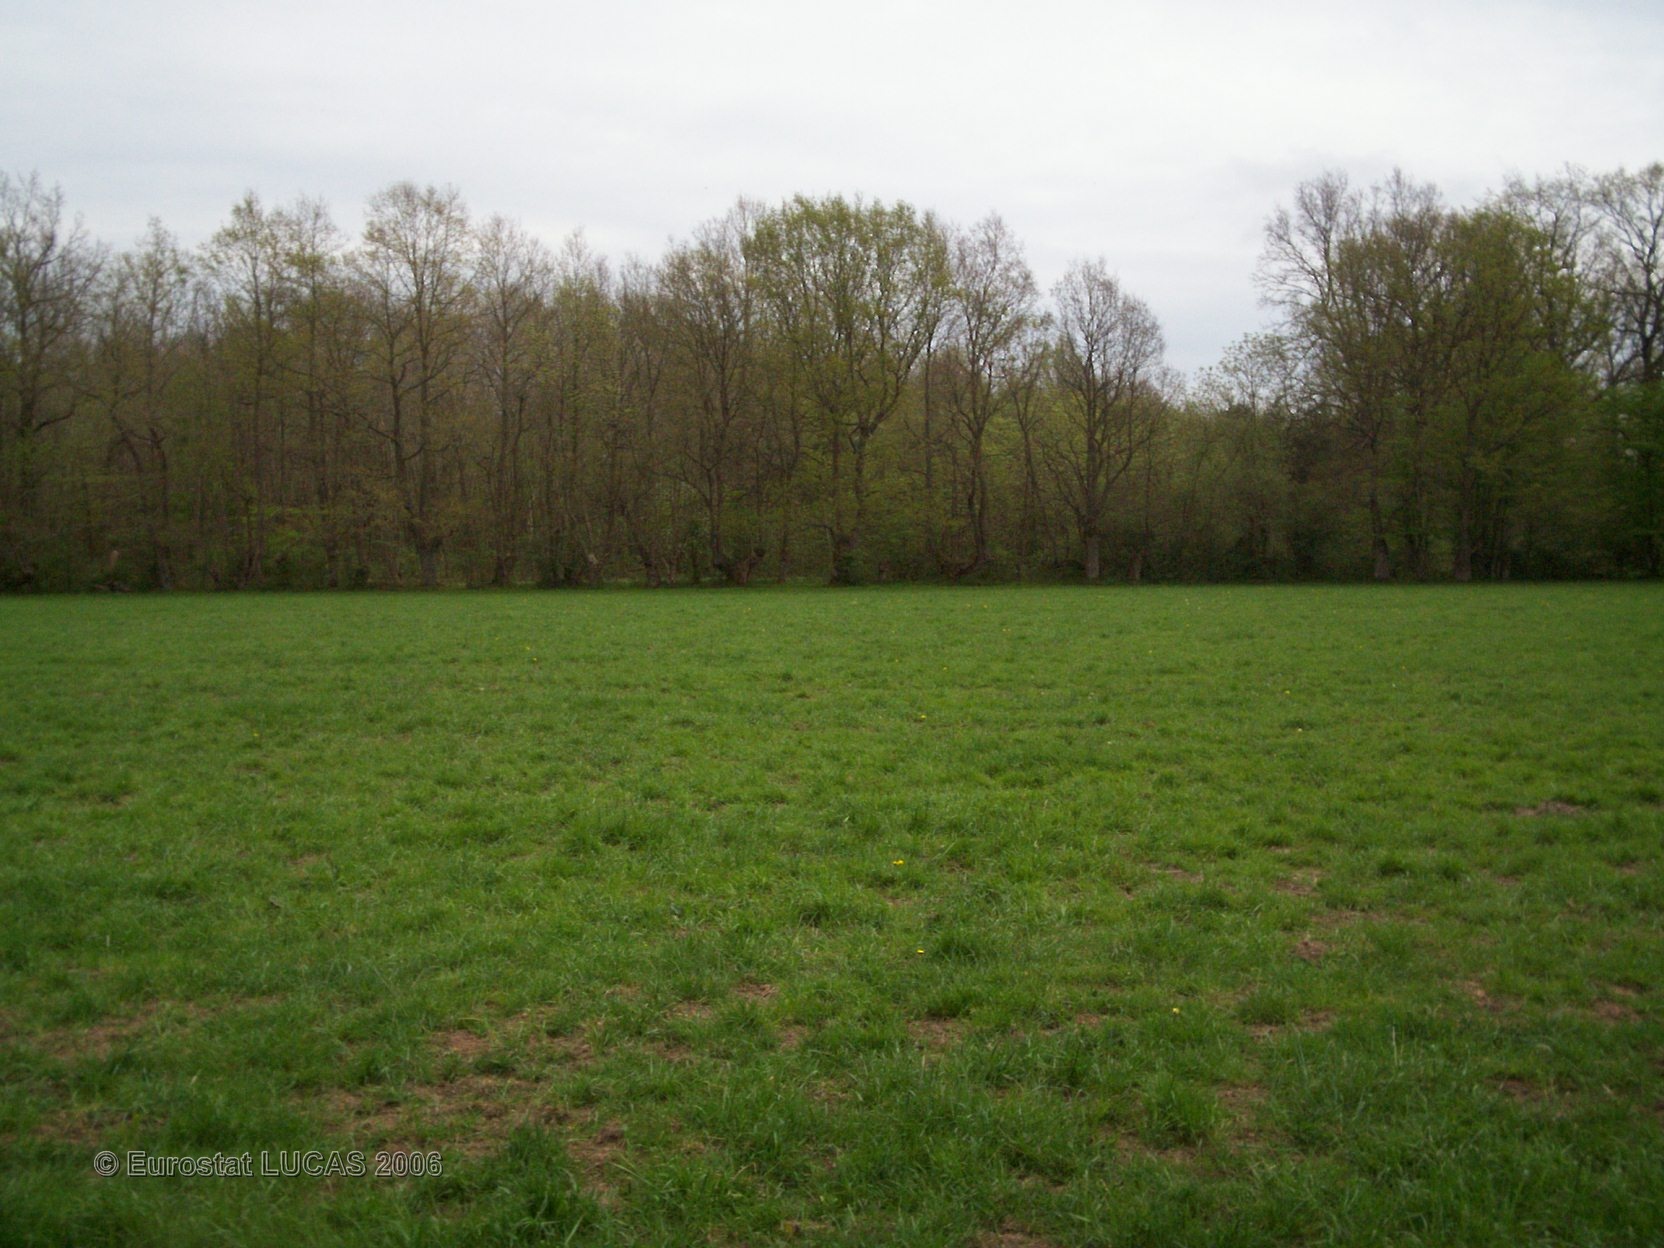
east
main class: Grassland
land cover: Grassland without tree/shrub cover
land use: Agriculture (excluding fallow land and kitchen gardens)
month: May
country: FR
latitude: 48.9034
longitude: 0.5478
